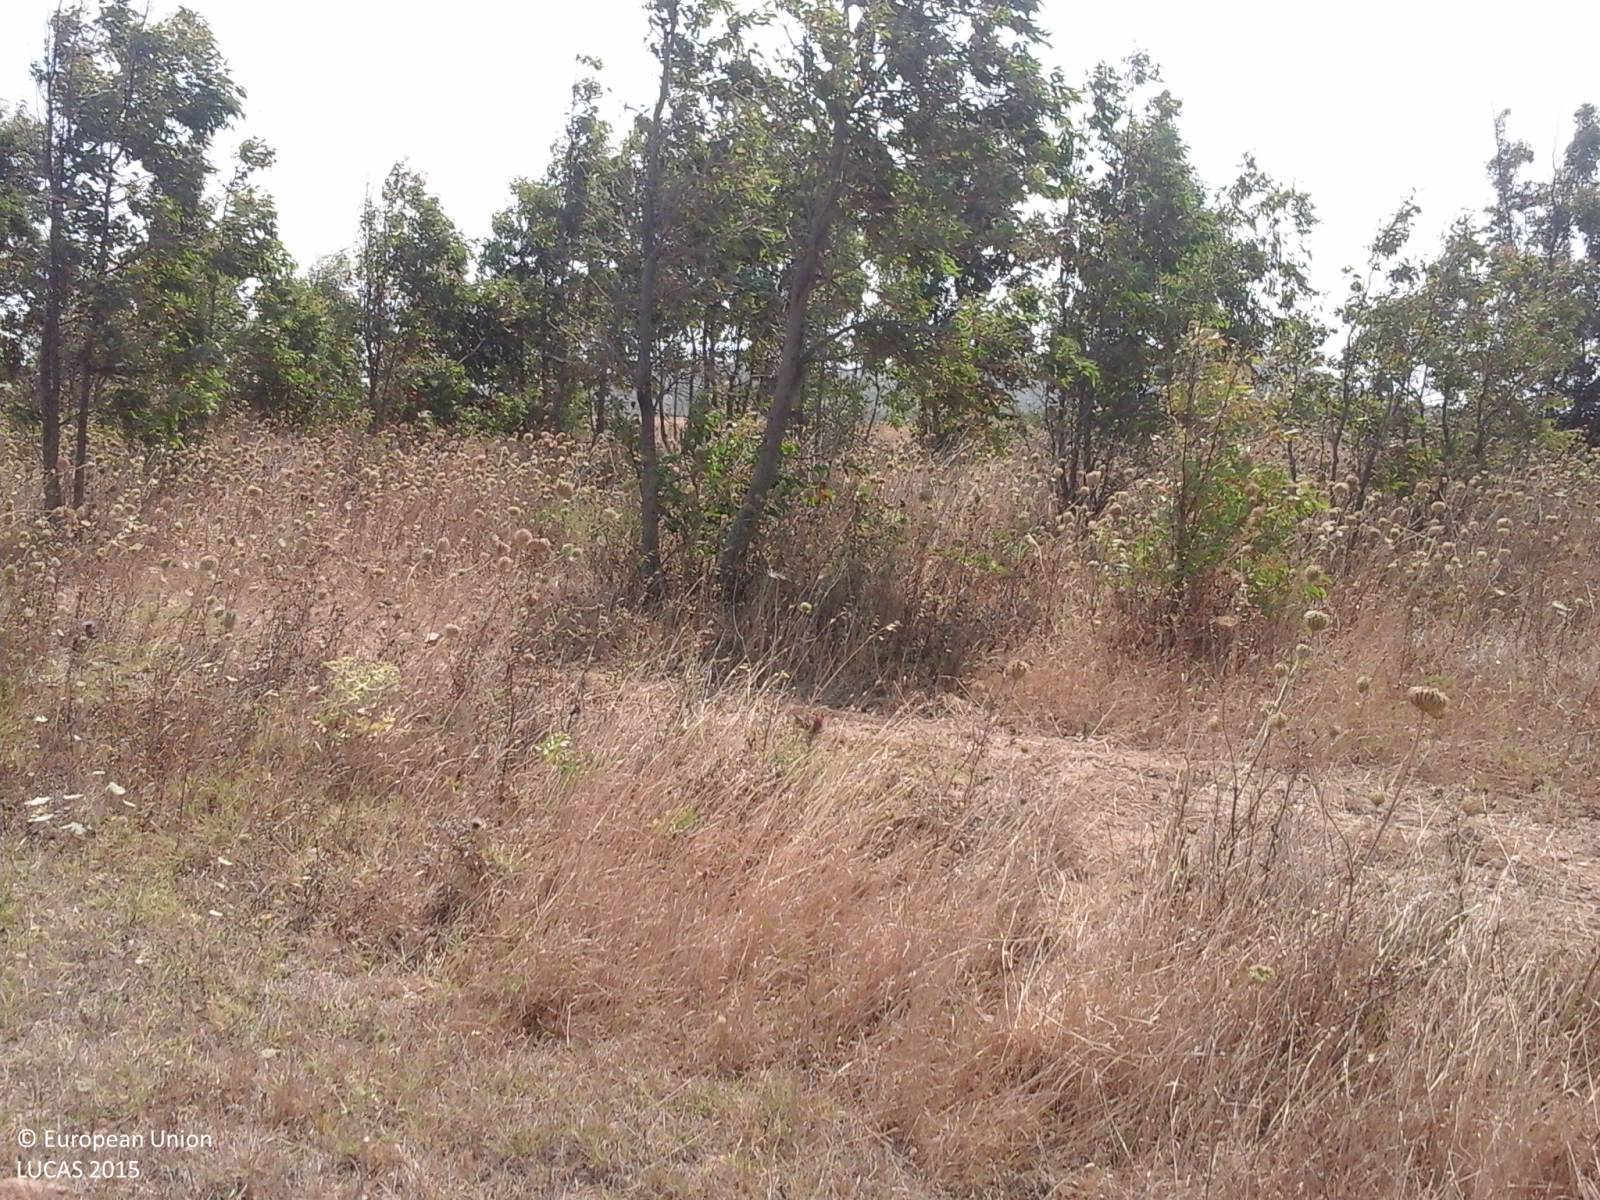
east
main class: Grassland
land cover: Grassland without tree/shrub cover
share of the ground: > 75 %
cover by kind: herbaceous plants 100 %
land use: Agriculture (excluding fallow land and kitchen gardens)
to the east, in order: Grassland without tree/shrub cover; Broadleaved woodland; Grassland without tree/shrub cover; Grass margins; Mixed cereals for fodder
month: July
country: IT
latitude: 39.6075
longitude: 8.7610
